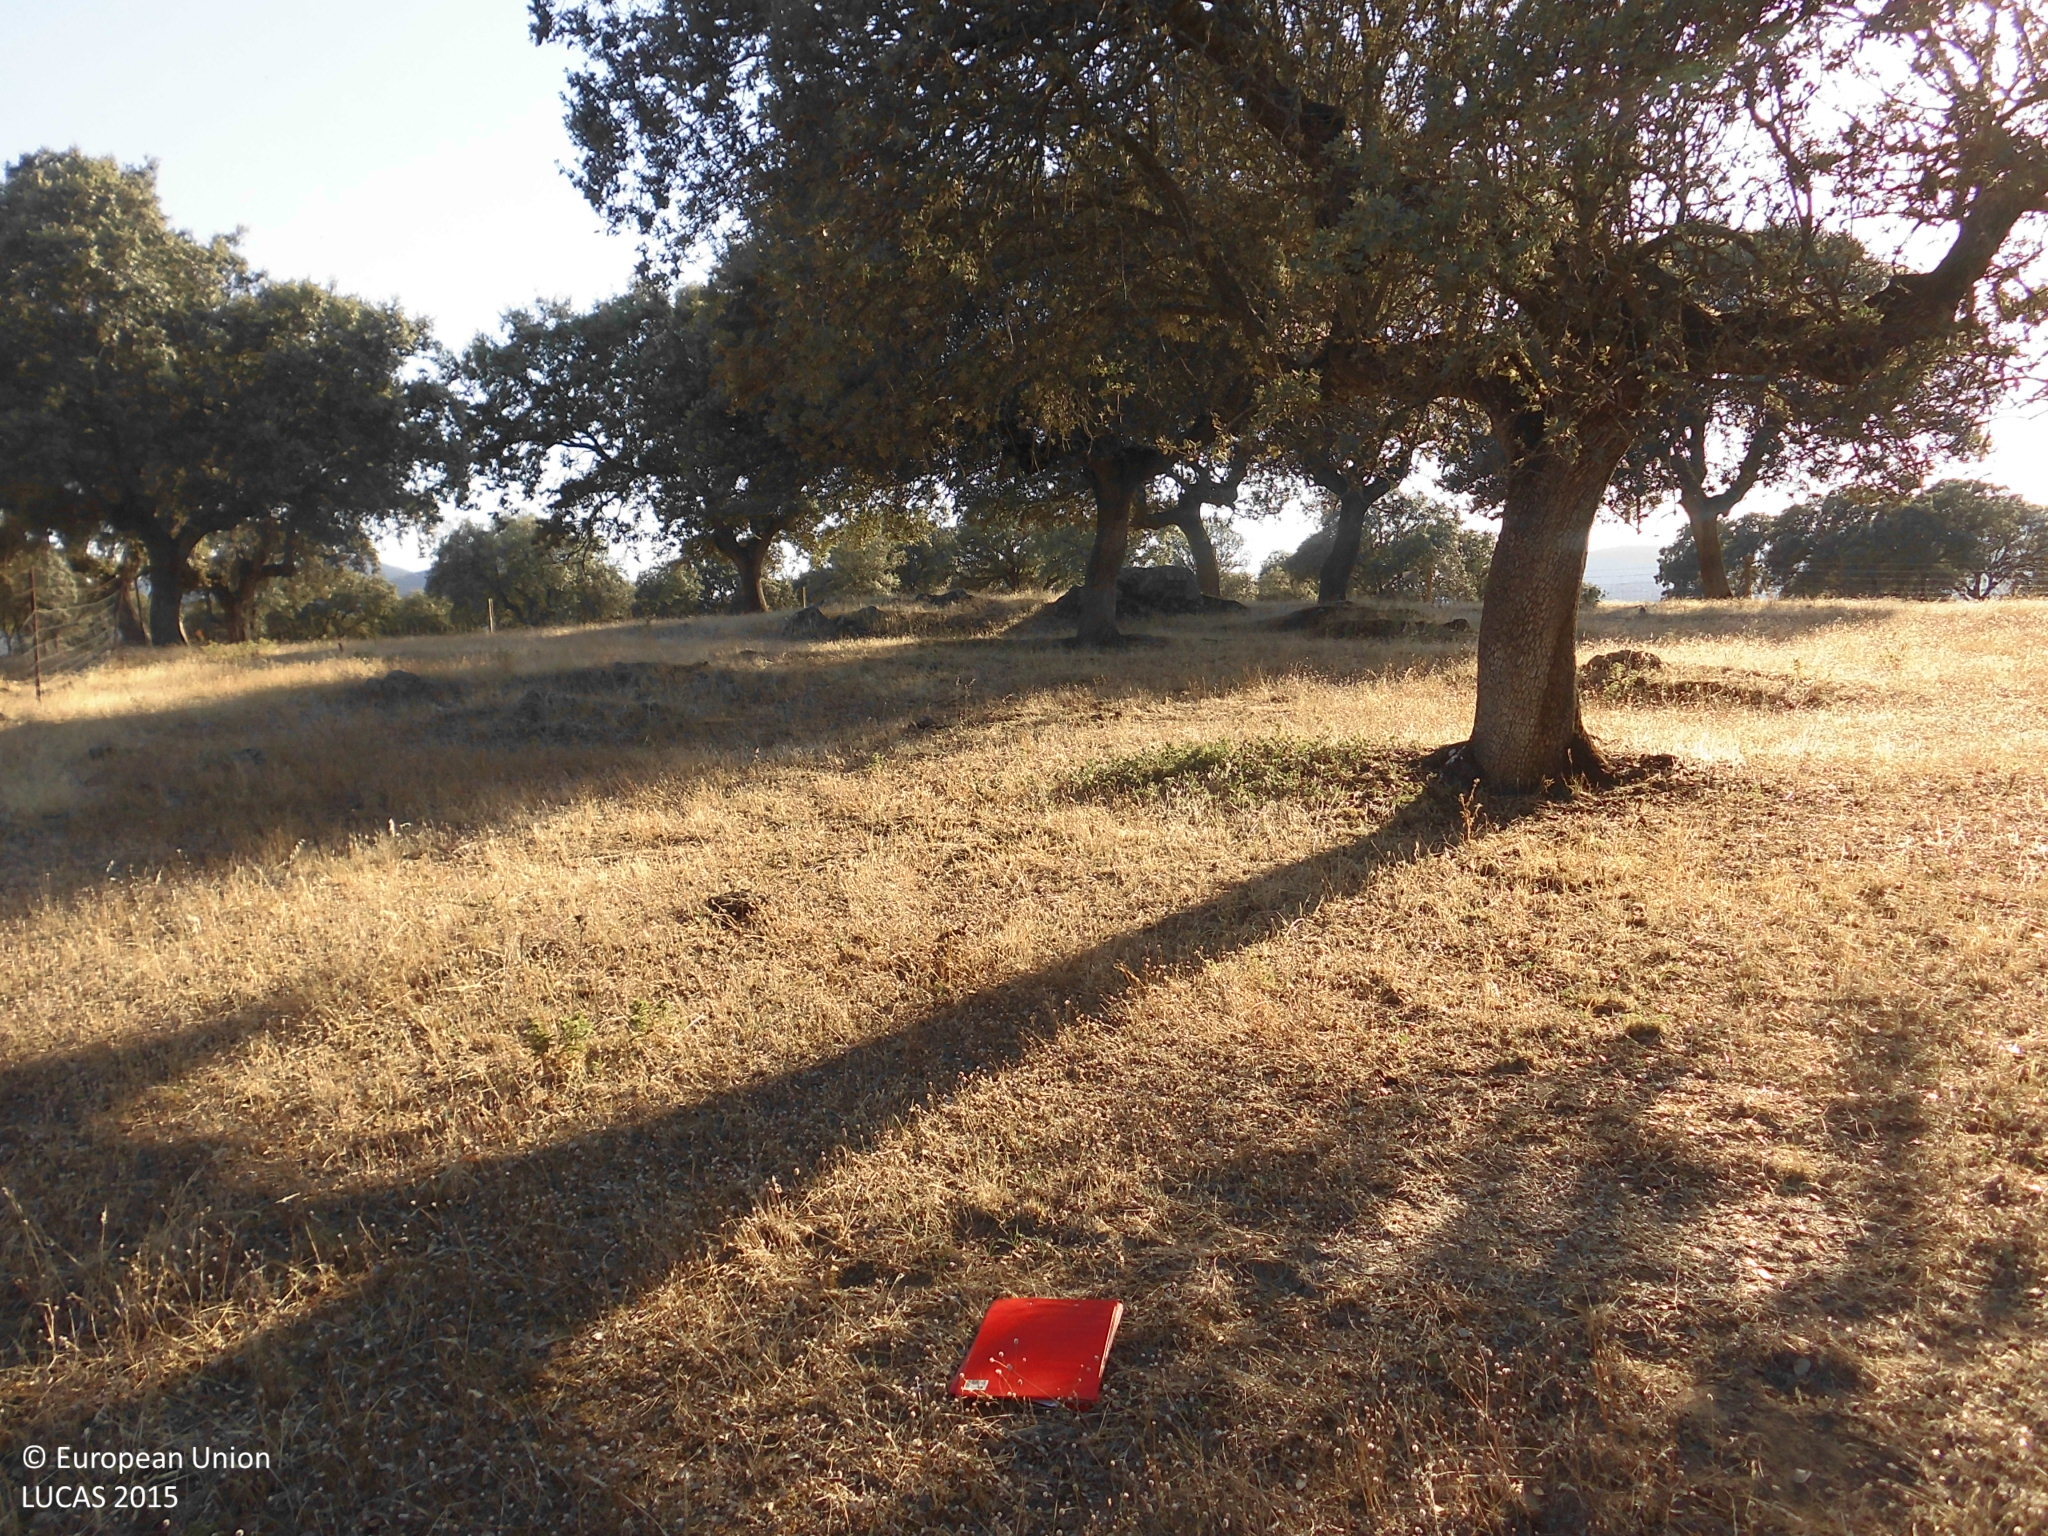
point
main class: Woodland
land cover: Broadleaved woodland
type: broadleaved evergreen forest
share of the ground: 25 - 50 %
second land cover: Grassland without tree/shrub cover
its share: > 75 %
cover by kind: broadleaved forest trees 50 %, herbaceous plants 50 %
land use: Forestry
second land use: Agriculture (excluding fallow land and kitchen gardens)
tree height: > 5 m
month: July
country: ES
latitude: 39.4928
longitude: -5.5762
